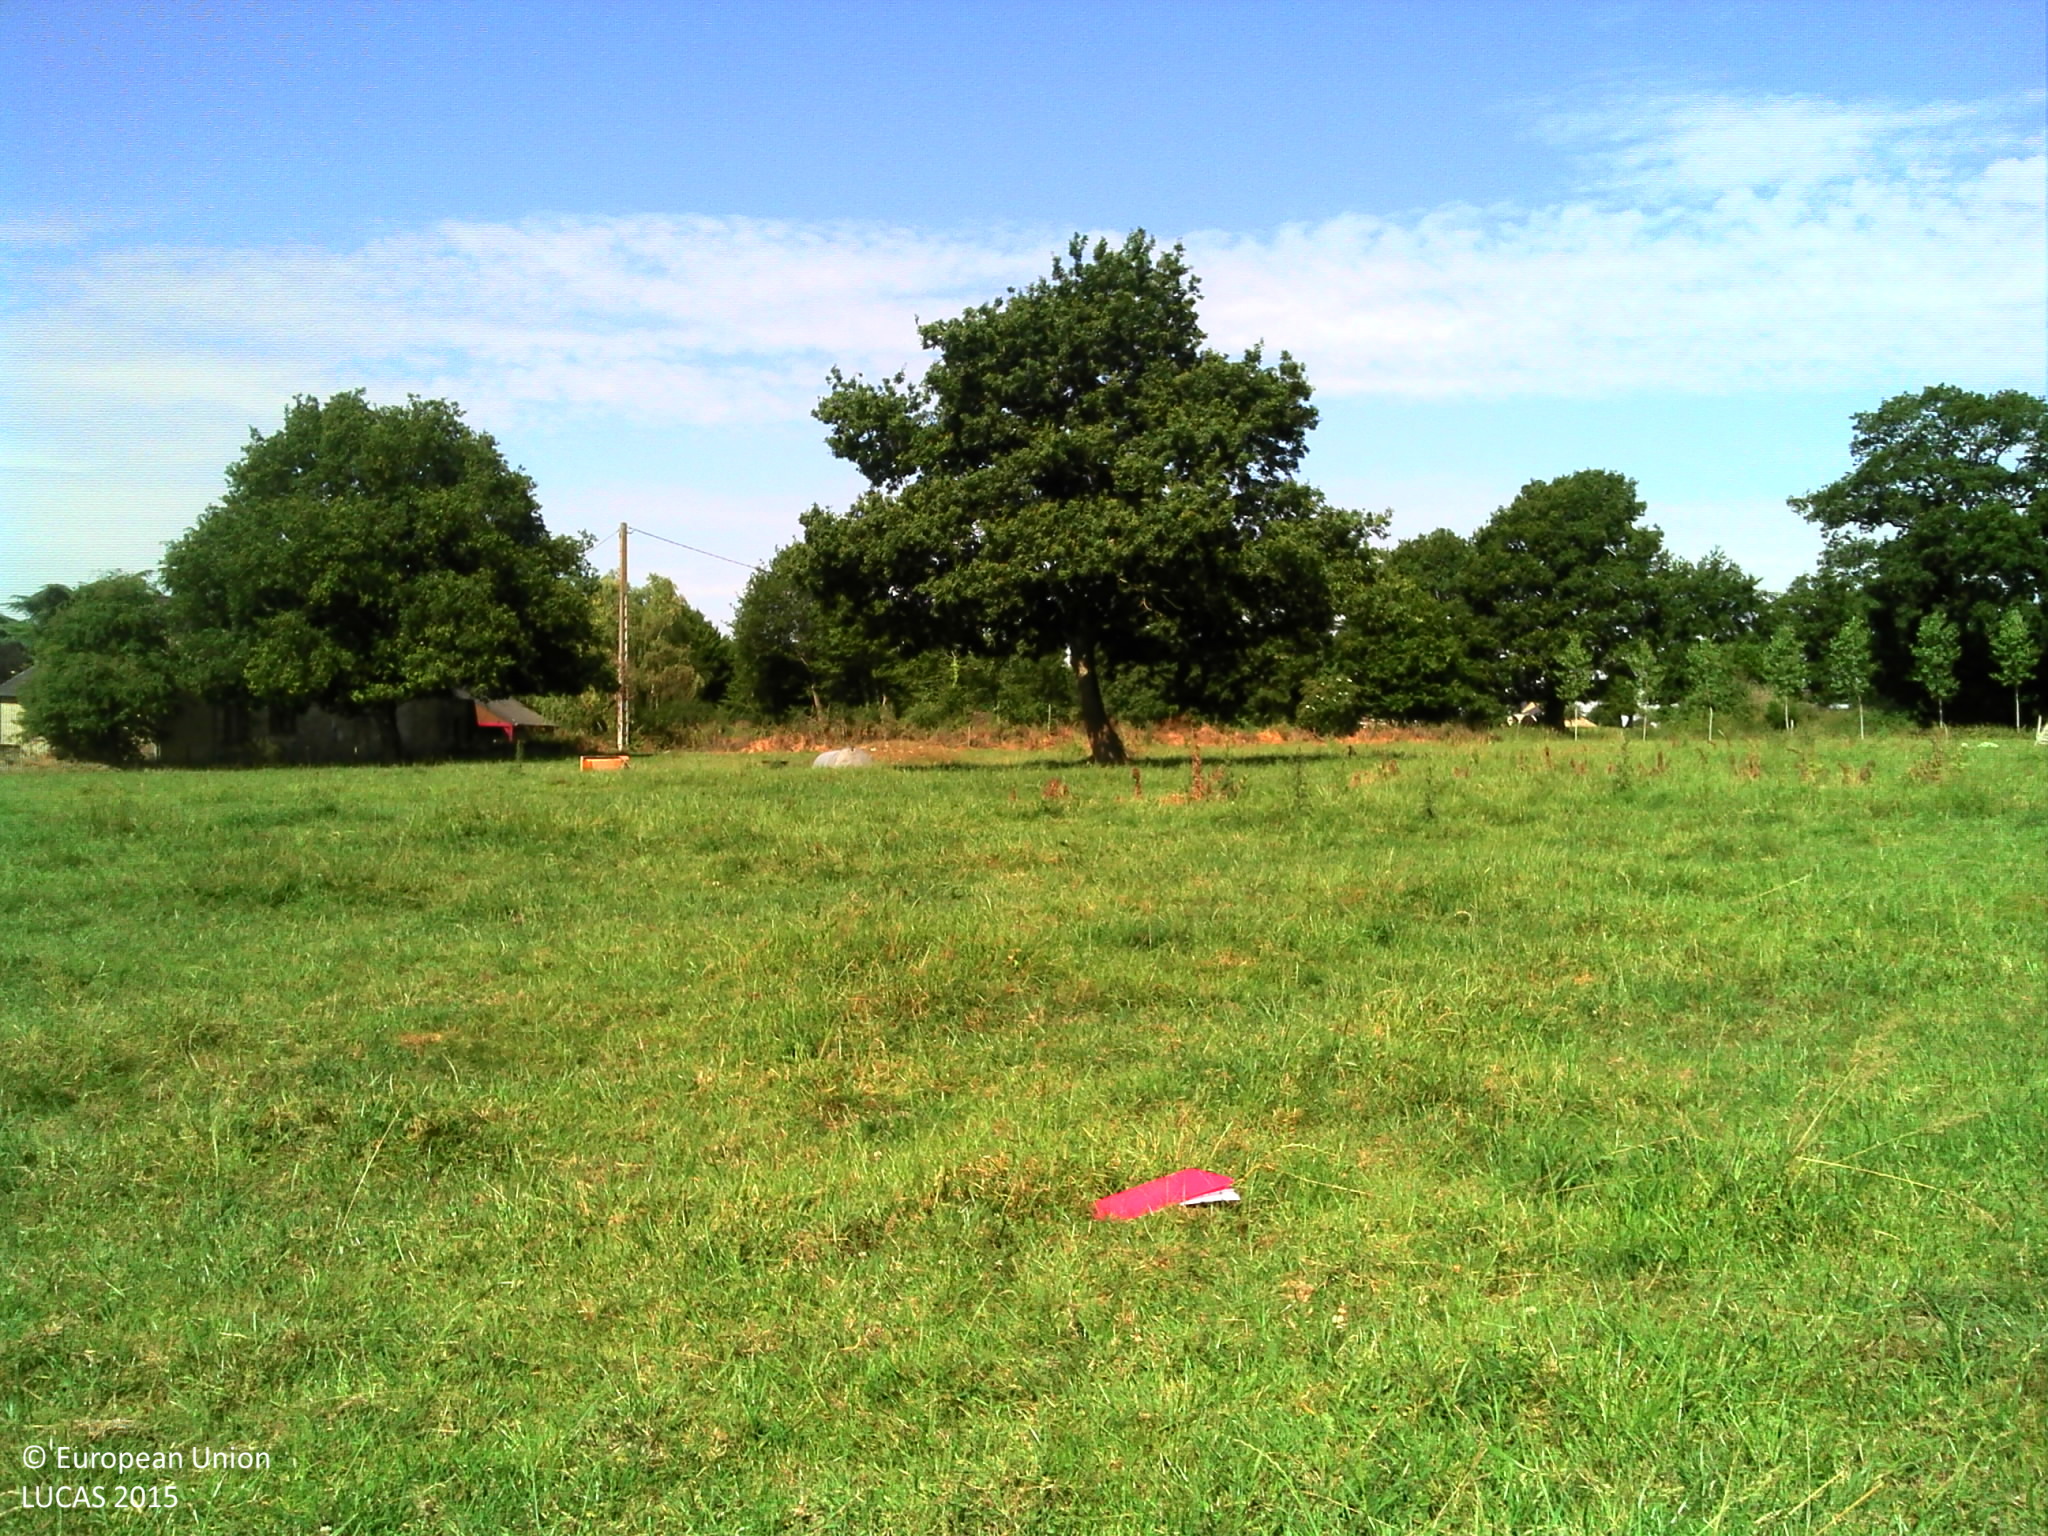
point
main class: Grassland
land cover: Grassland without tree/shrub cover
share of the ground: > 75 %
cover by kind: herbaceous plants 100 %
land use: Agriculture (excluding fallow land and kitchen gardens)
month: June
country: FR
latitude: 47.9760
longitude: -2.0695
